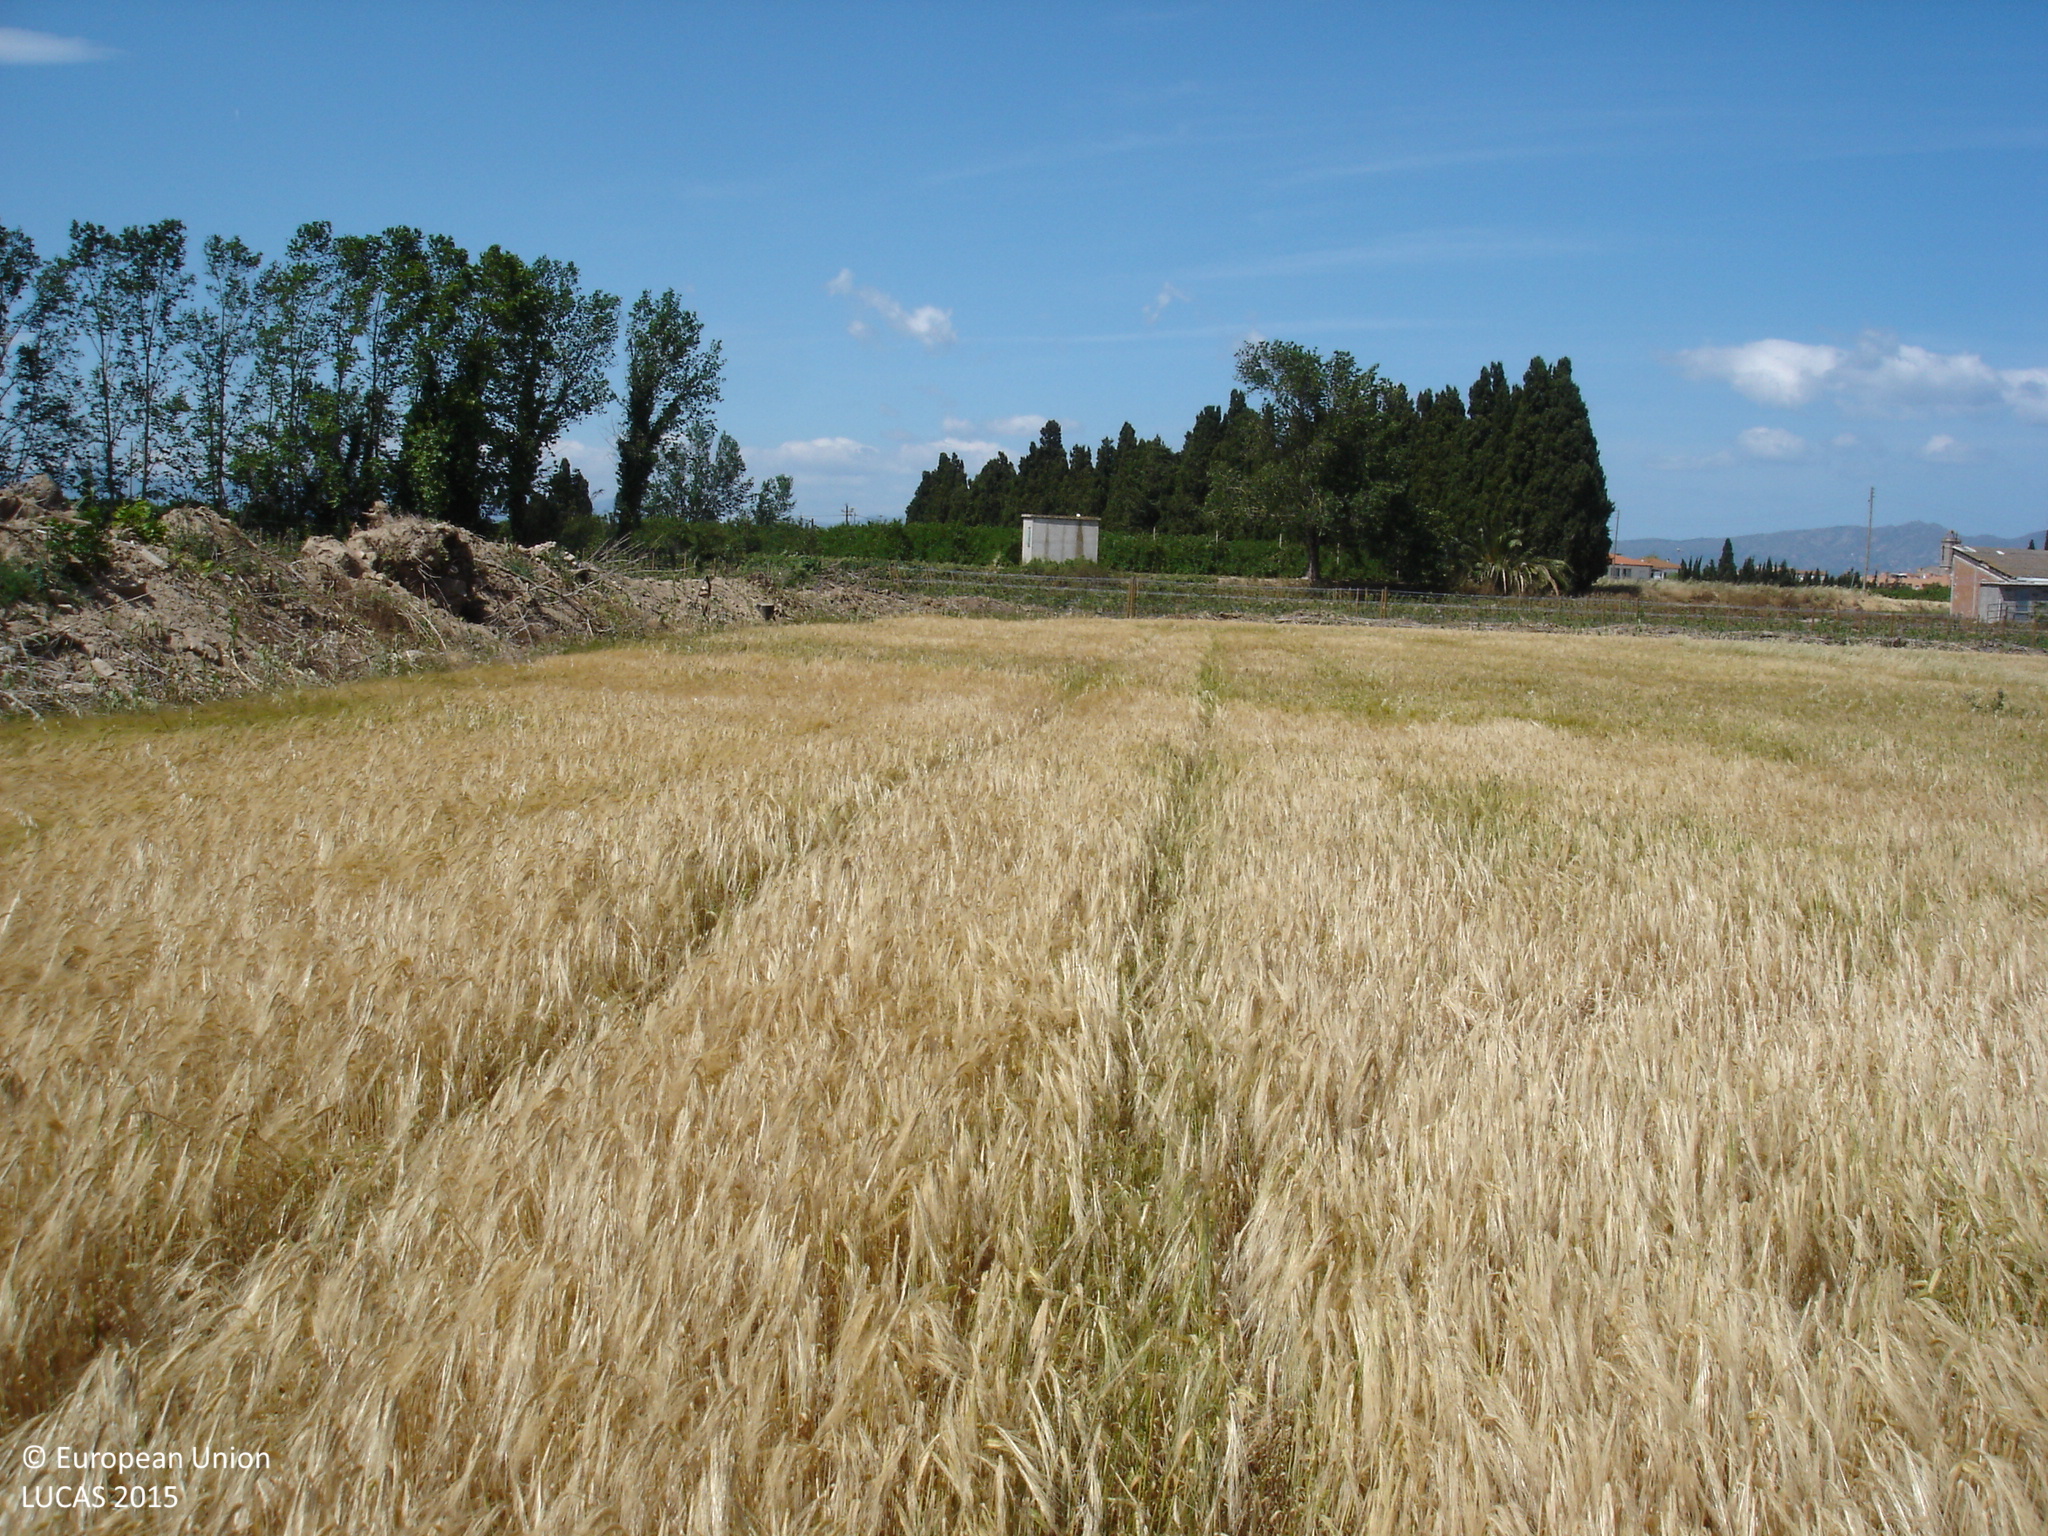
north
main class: Cropland
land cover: Barley
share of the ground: > 75 %
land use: Agriculture (excluding fallow land and kitchen gardens)
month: May
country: ES
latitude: 42.1814
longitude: 3.0773
